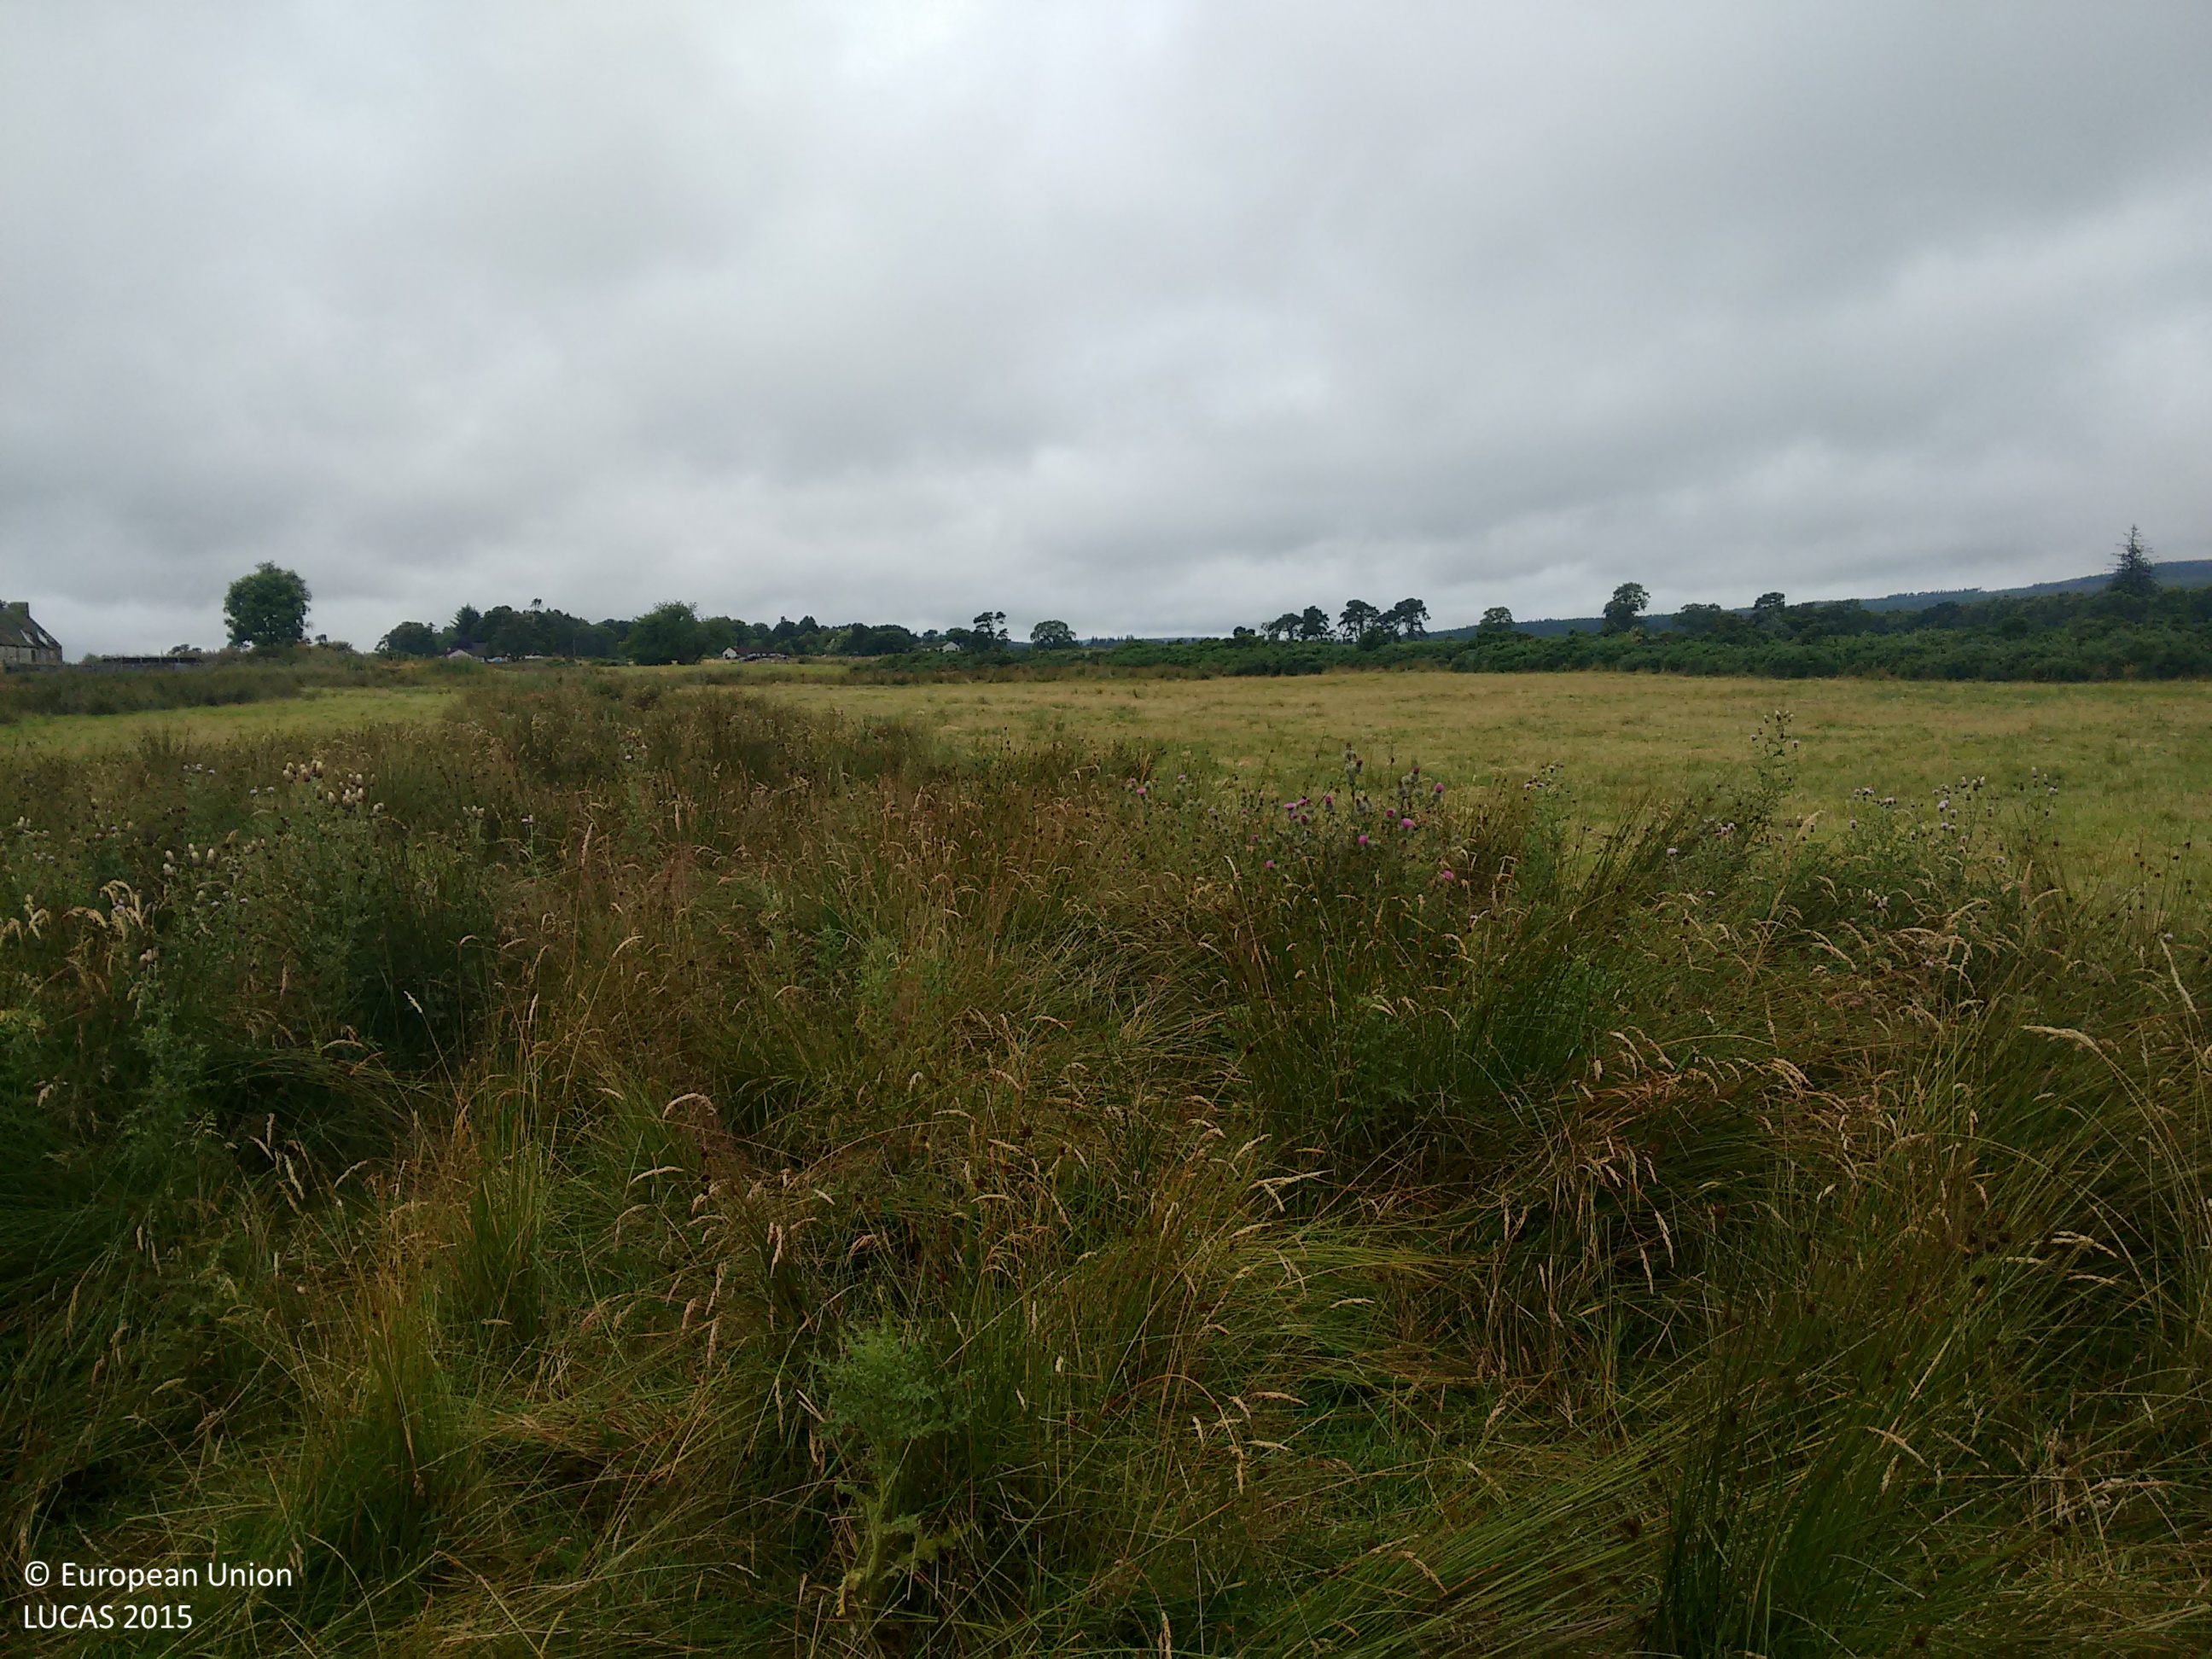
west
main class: Grassland
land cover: Grassland without tree/shrub cover
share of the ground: > 75 %
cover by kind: herbaceous plants 100 %
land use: Agriculture (excluding fallow land and kitchen gardens)
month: August
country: GB
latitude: 57.7867
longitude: -4.0567
